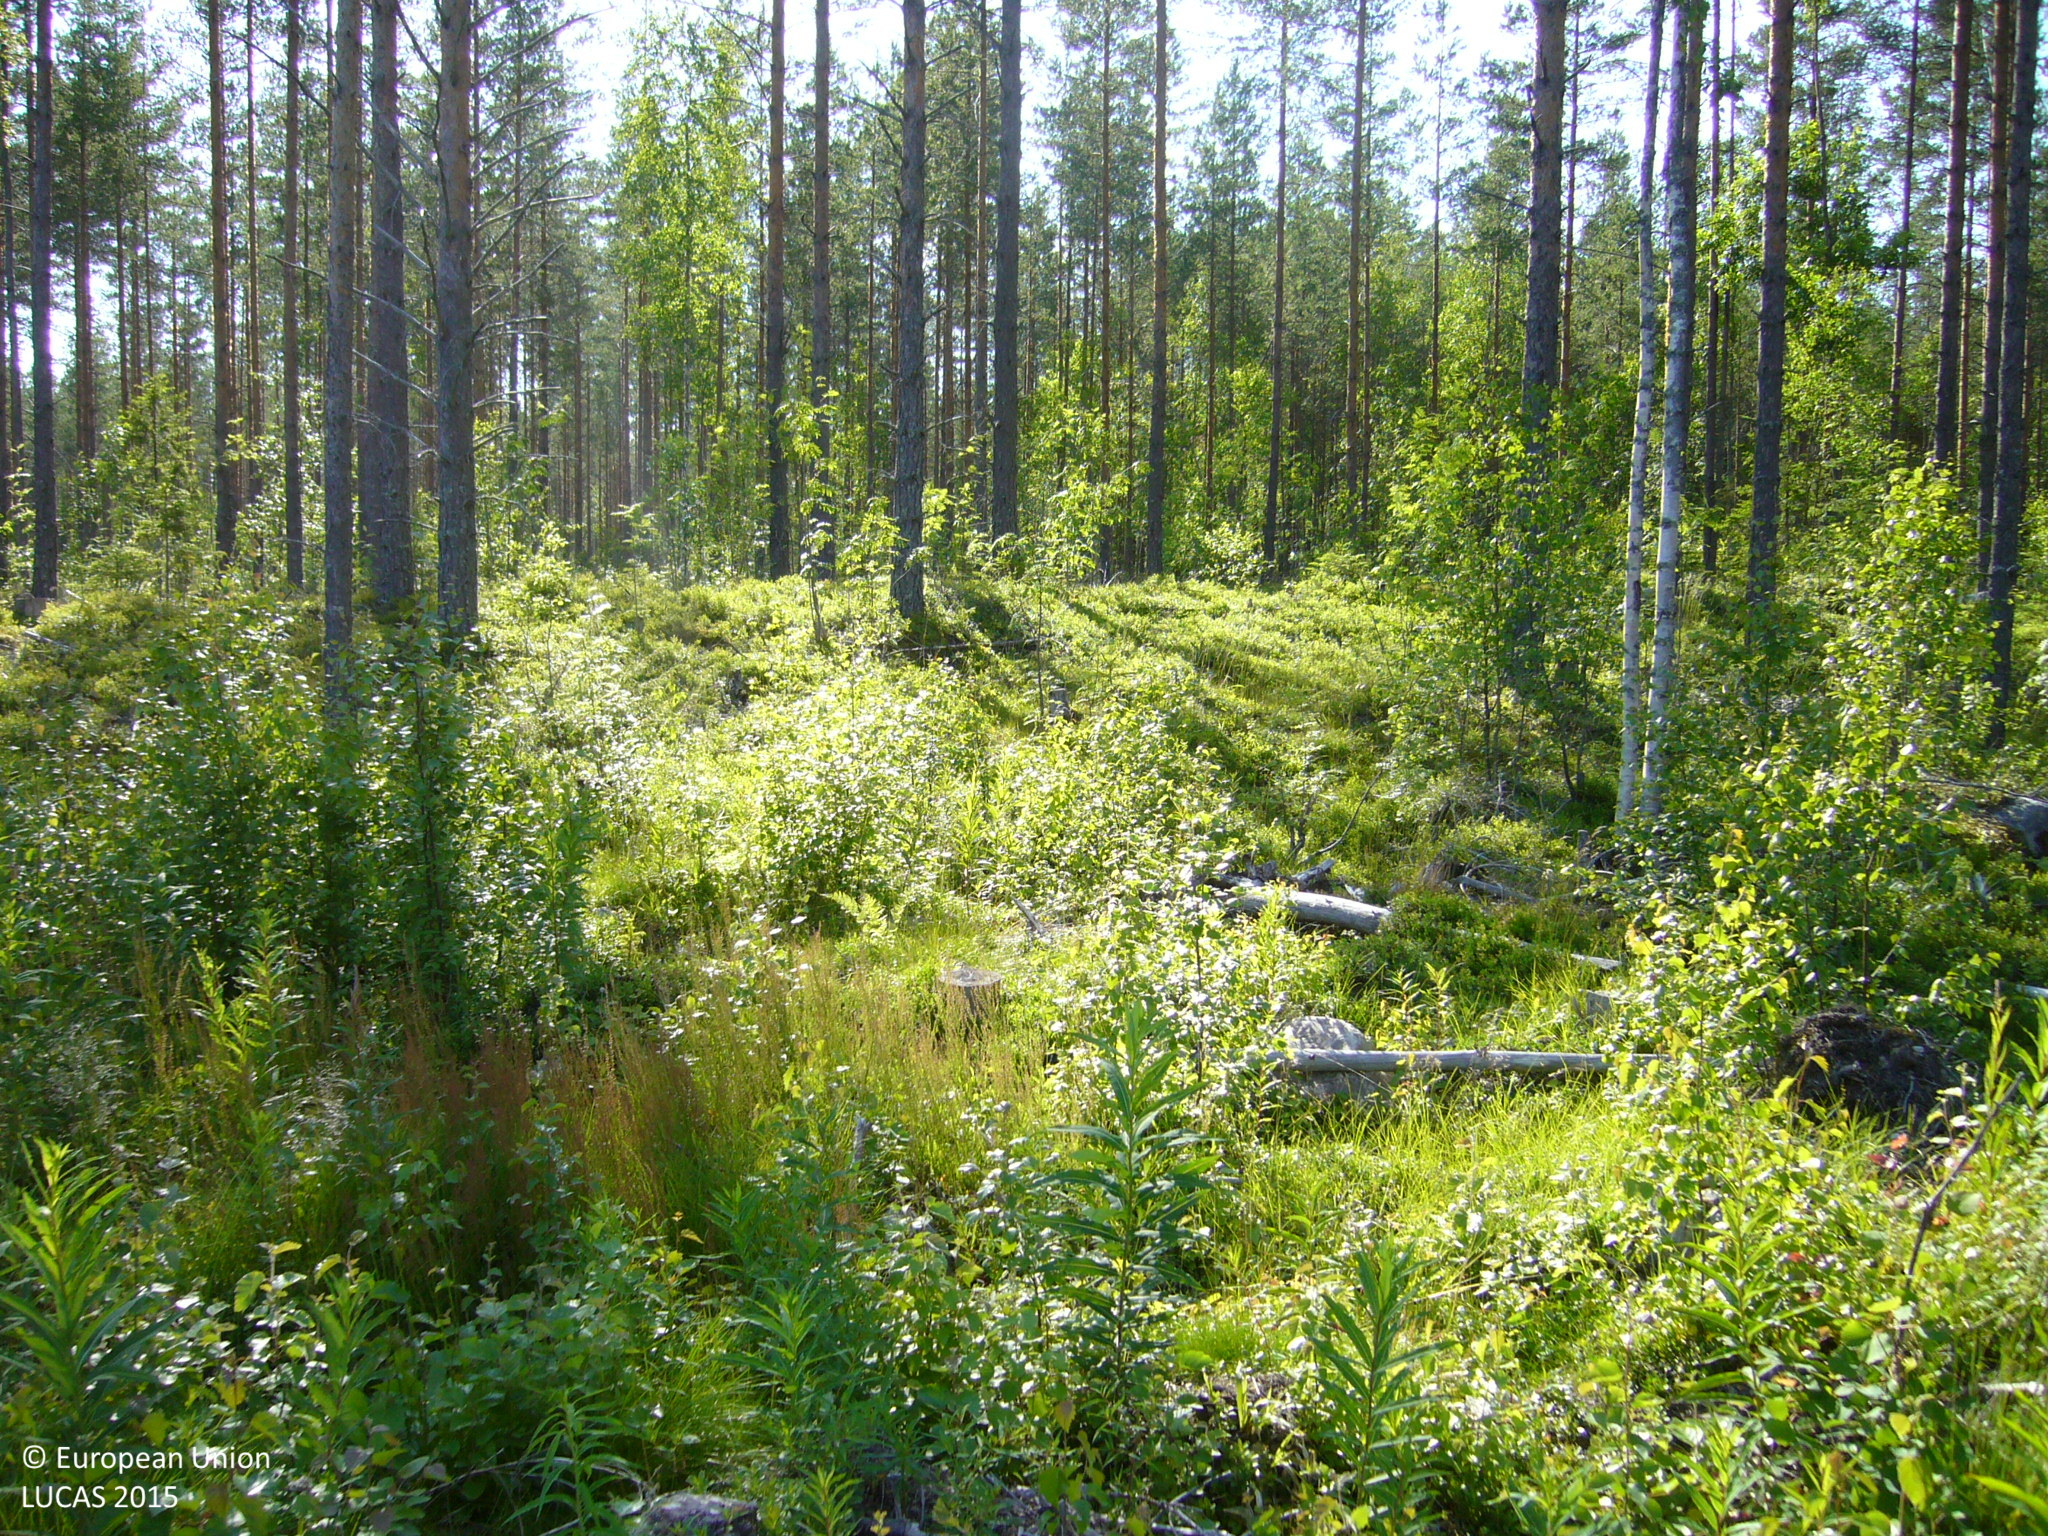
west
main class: Shrubland
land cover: Shrubland with sparse tree cover
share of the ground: 25 - 50 %
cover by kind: shrubs 40 %, herbaceous plants 25 %, lichens and mosses 20 %, broadleaved forest trees 5 %
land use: Forestry
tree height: < 5 m
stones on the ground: 25 - 50 %
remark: Clear cut
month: July
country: FI
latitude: 63.3491
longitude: 25.7145
